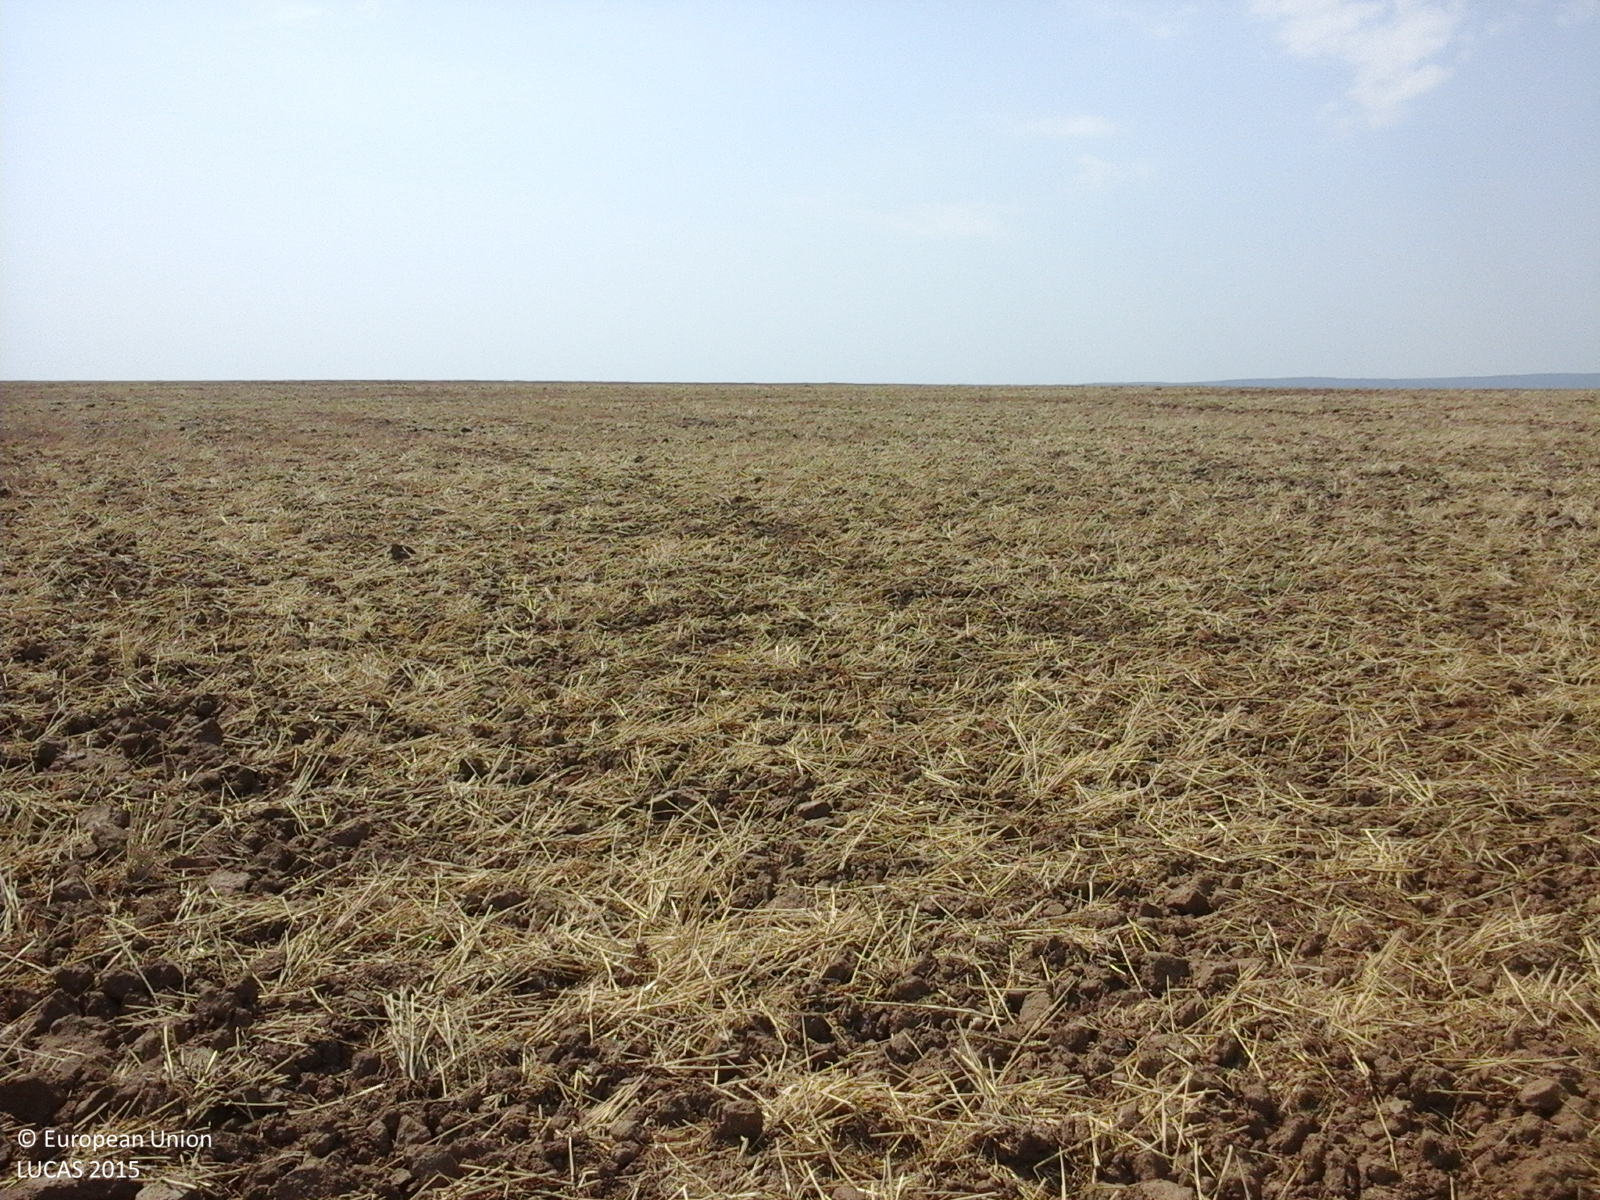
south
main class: Cropland
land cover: Common wheat
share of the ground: 10 - 25 %
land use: Agriculture (excluding fallow land and kitchen gardens)
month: August
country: RO
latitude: 46.1529
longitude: 27.1236
